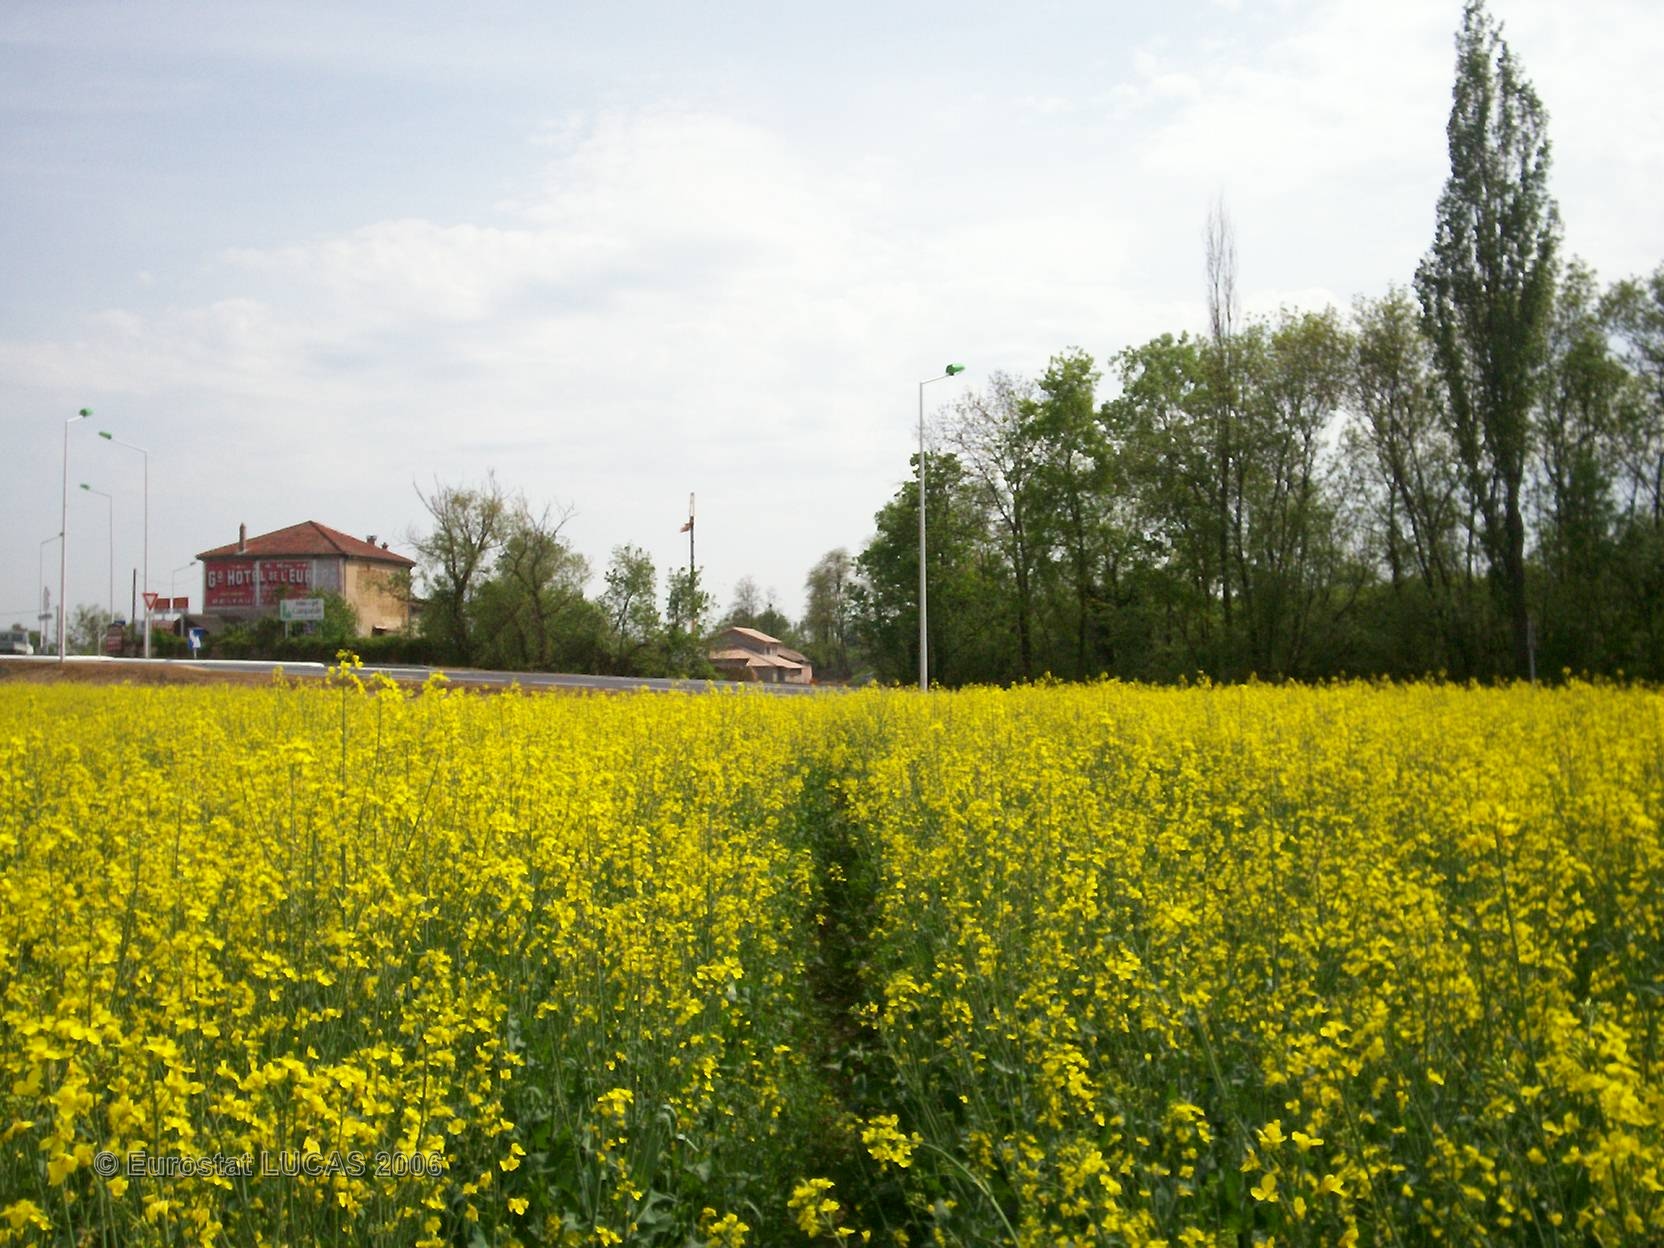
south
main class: Cropland
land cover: Rape and turnip rape
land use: Agriculture (excluding fallow land and kitchen gardens)
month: May
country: FR
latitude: 46.0222
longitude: 4.7195
